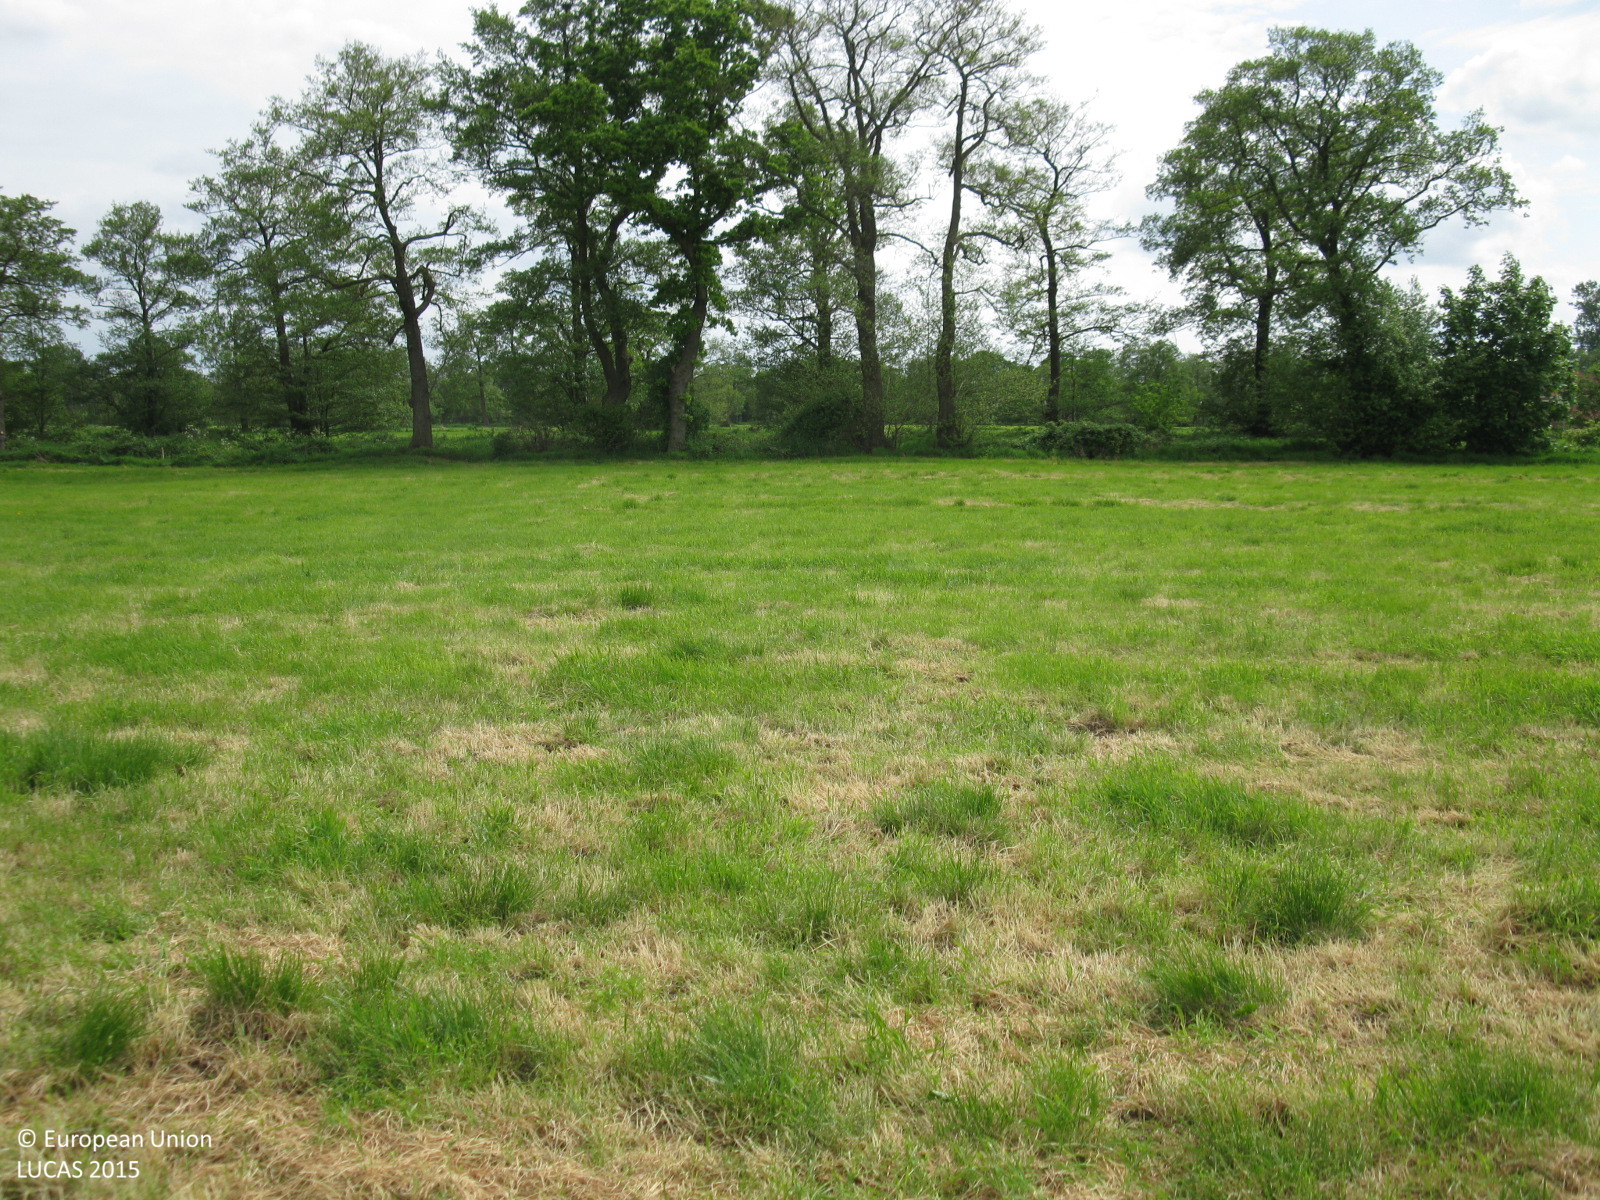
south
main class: Grassland
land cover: Grassland without tree/shrub cover
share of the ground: > 75 %
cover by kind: herbaceous plants 100 %
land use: Agriculture (excluding fallow land and kitchen gardens)
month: June
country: DE
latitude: 53.1207
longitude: 7.3258
